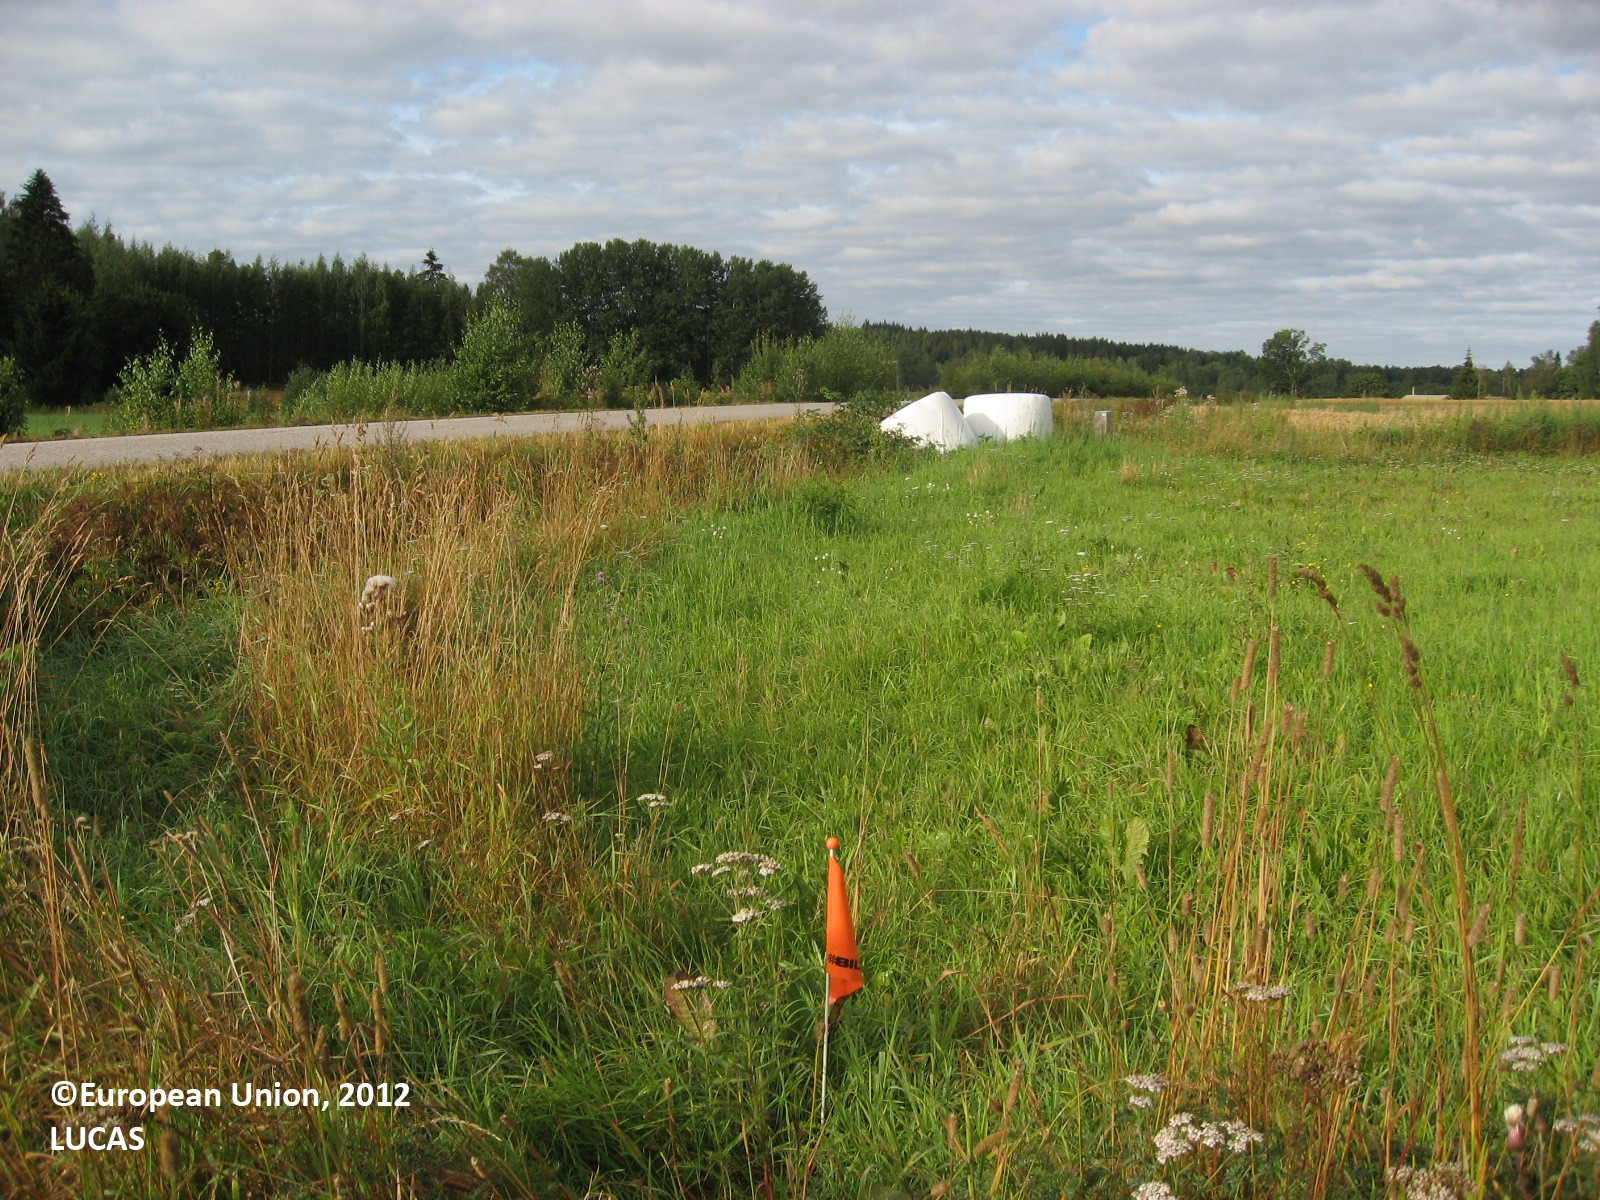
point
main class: Cropland
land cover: Temporary grasslands
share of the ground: > 75 %
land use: Agriculture (excluding fallow land and kitchen gardens)
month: August
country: FI
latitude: 61.1606
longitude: 24.7705
